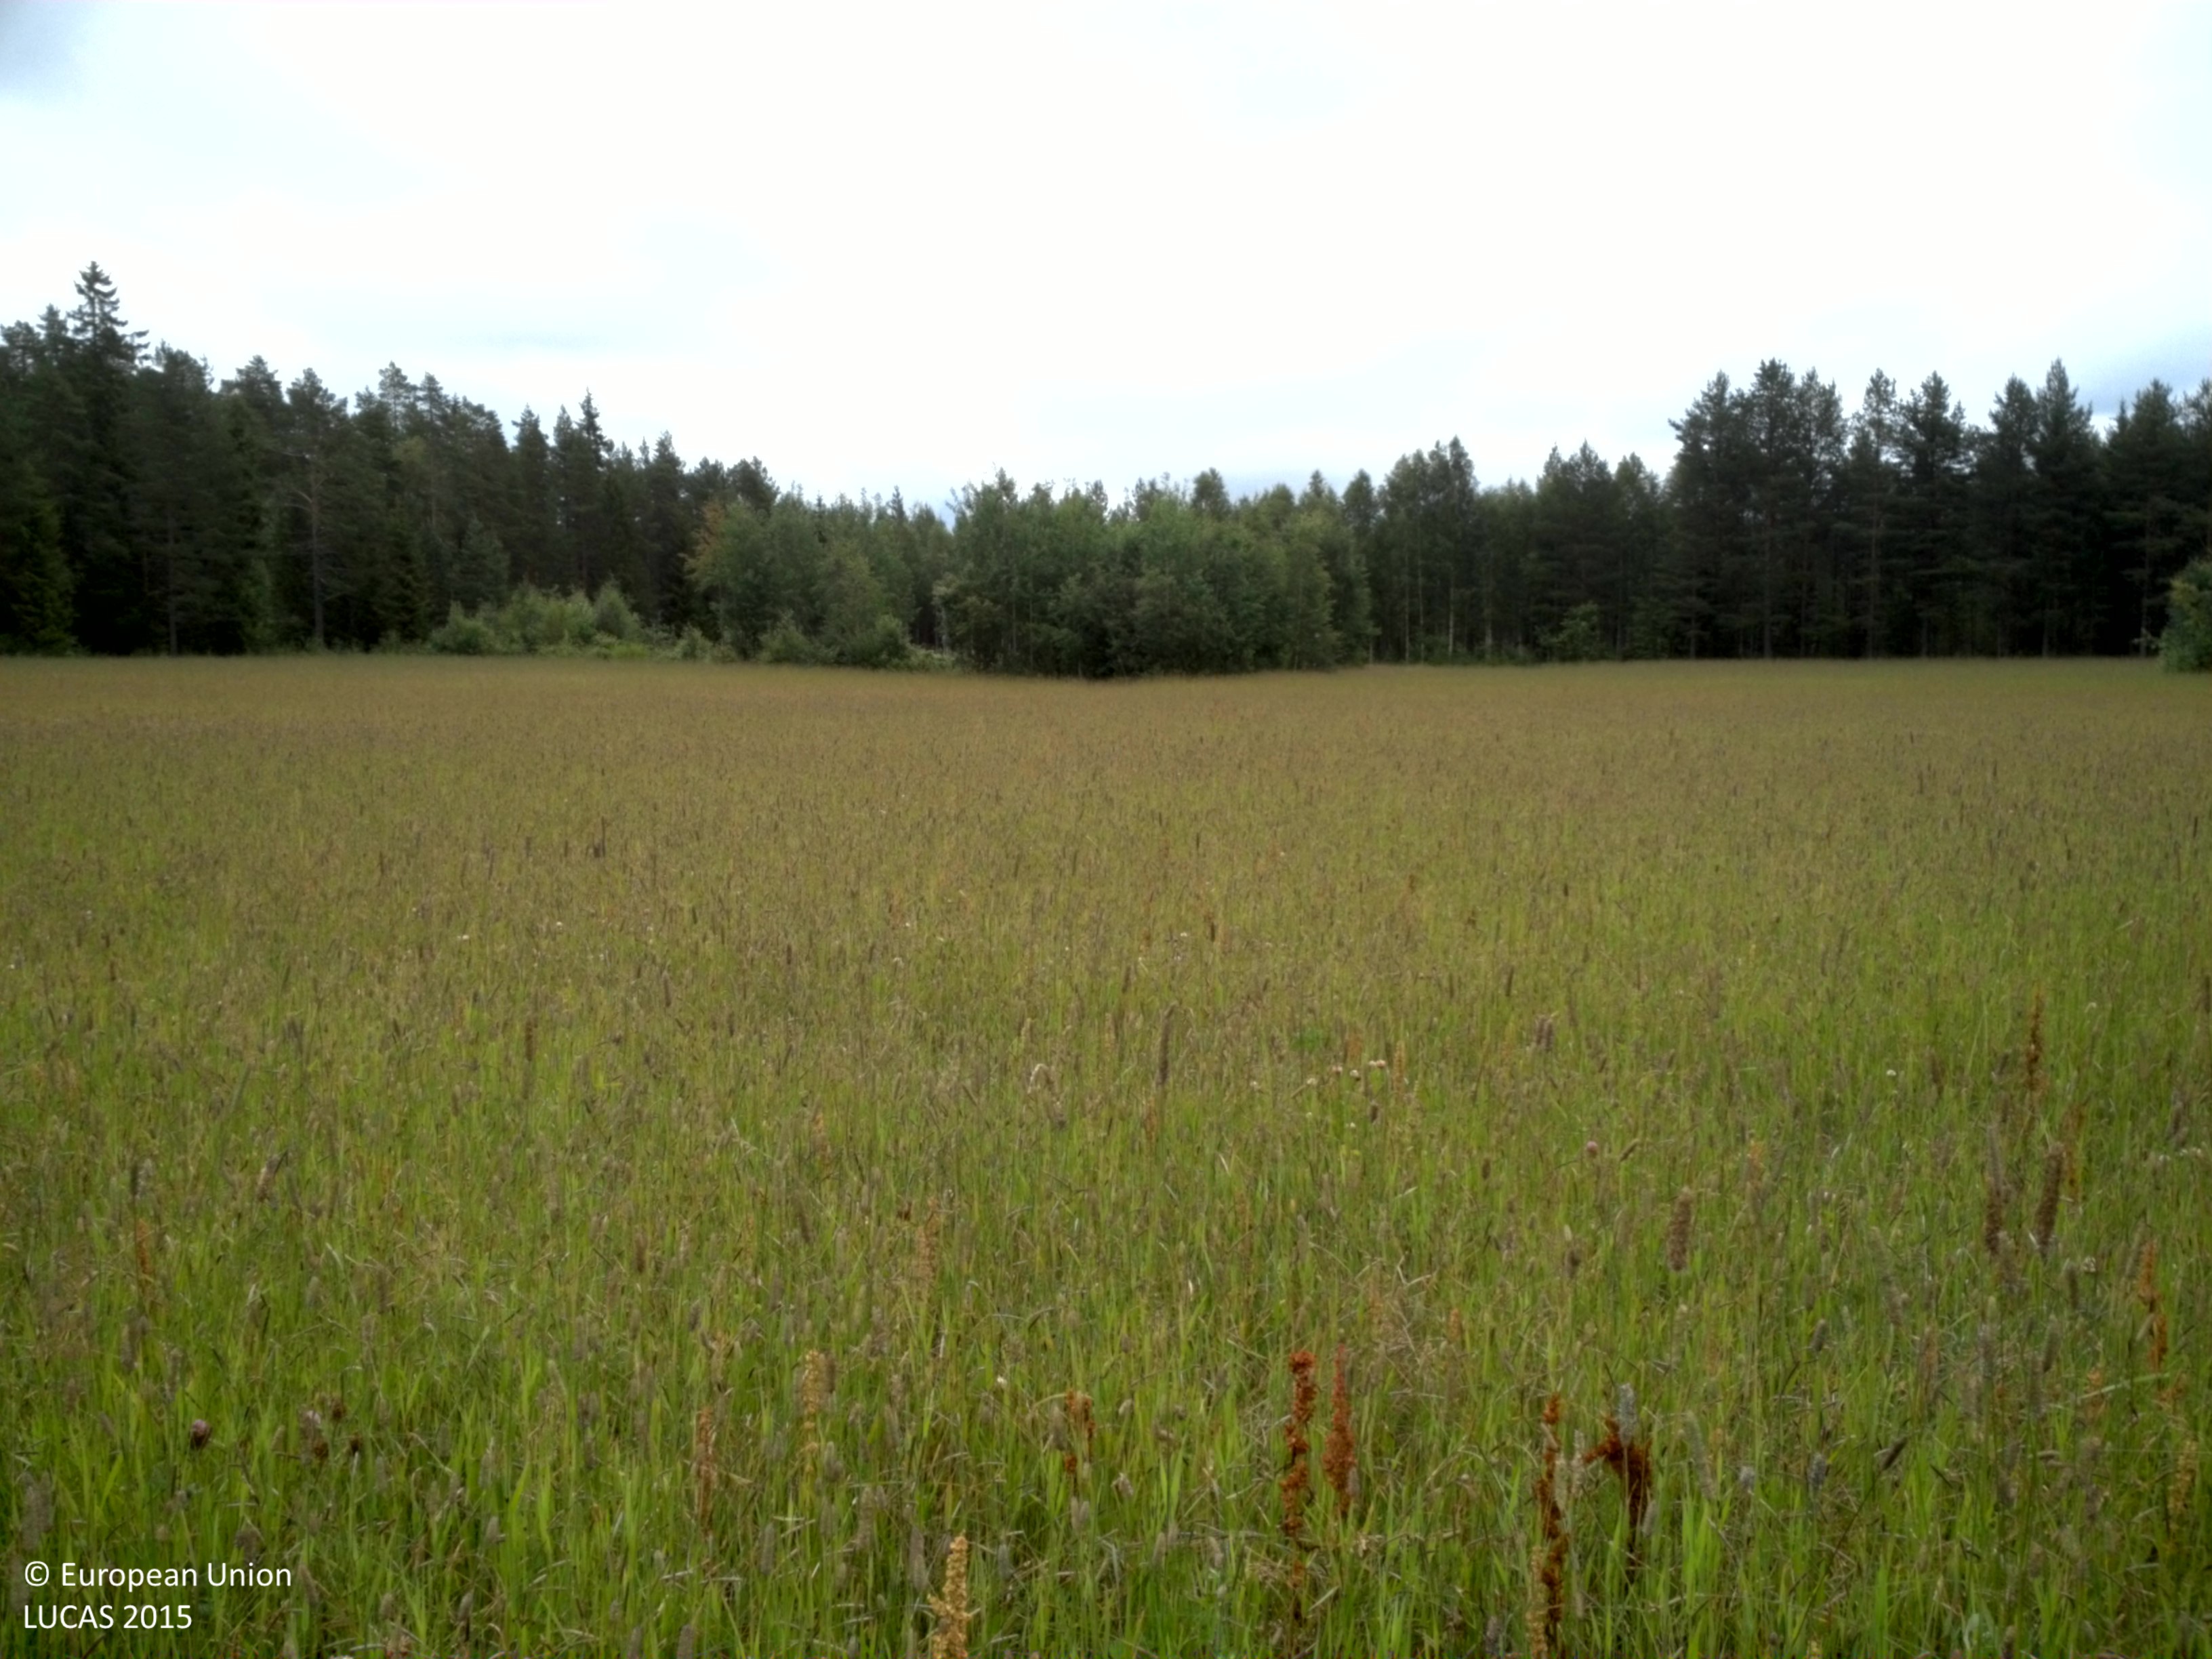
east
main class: Grassland
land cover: Grassland without tree/shrub cover
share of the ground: > 75 %
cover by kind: herbaceous plants 100 %
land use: Agriculture (excluding fallow land and kitchen gardens)
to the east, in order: Grassland without tree/shrub cover; Ditches and canals; Broadleaved woodland; Shrubland with sparse tree cover; Ditches and canals; Other leguminous and mixtures for fodder; Ditches and canals; Broadleaved woodland; Pine dominated mixed woodland; Pine dominated coniferous woodland
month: August
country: SE
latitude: 64.7275
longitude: 20.9999
